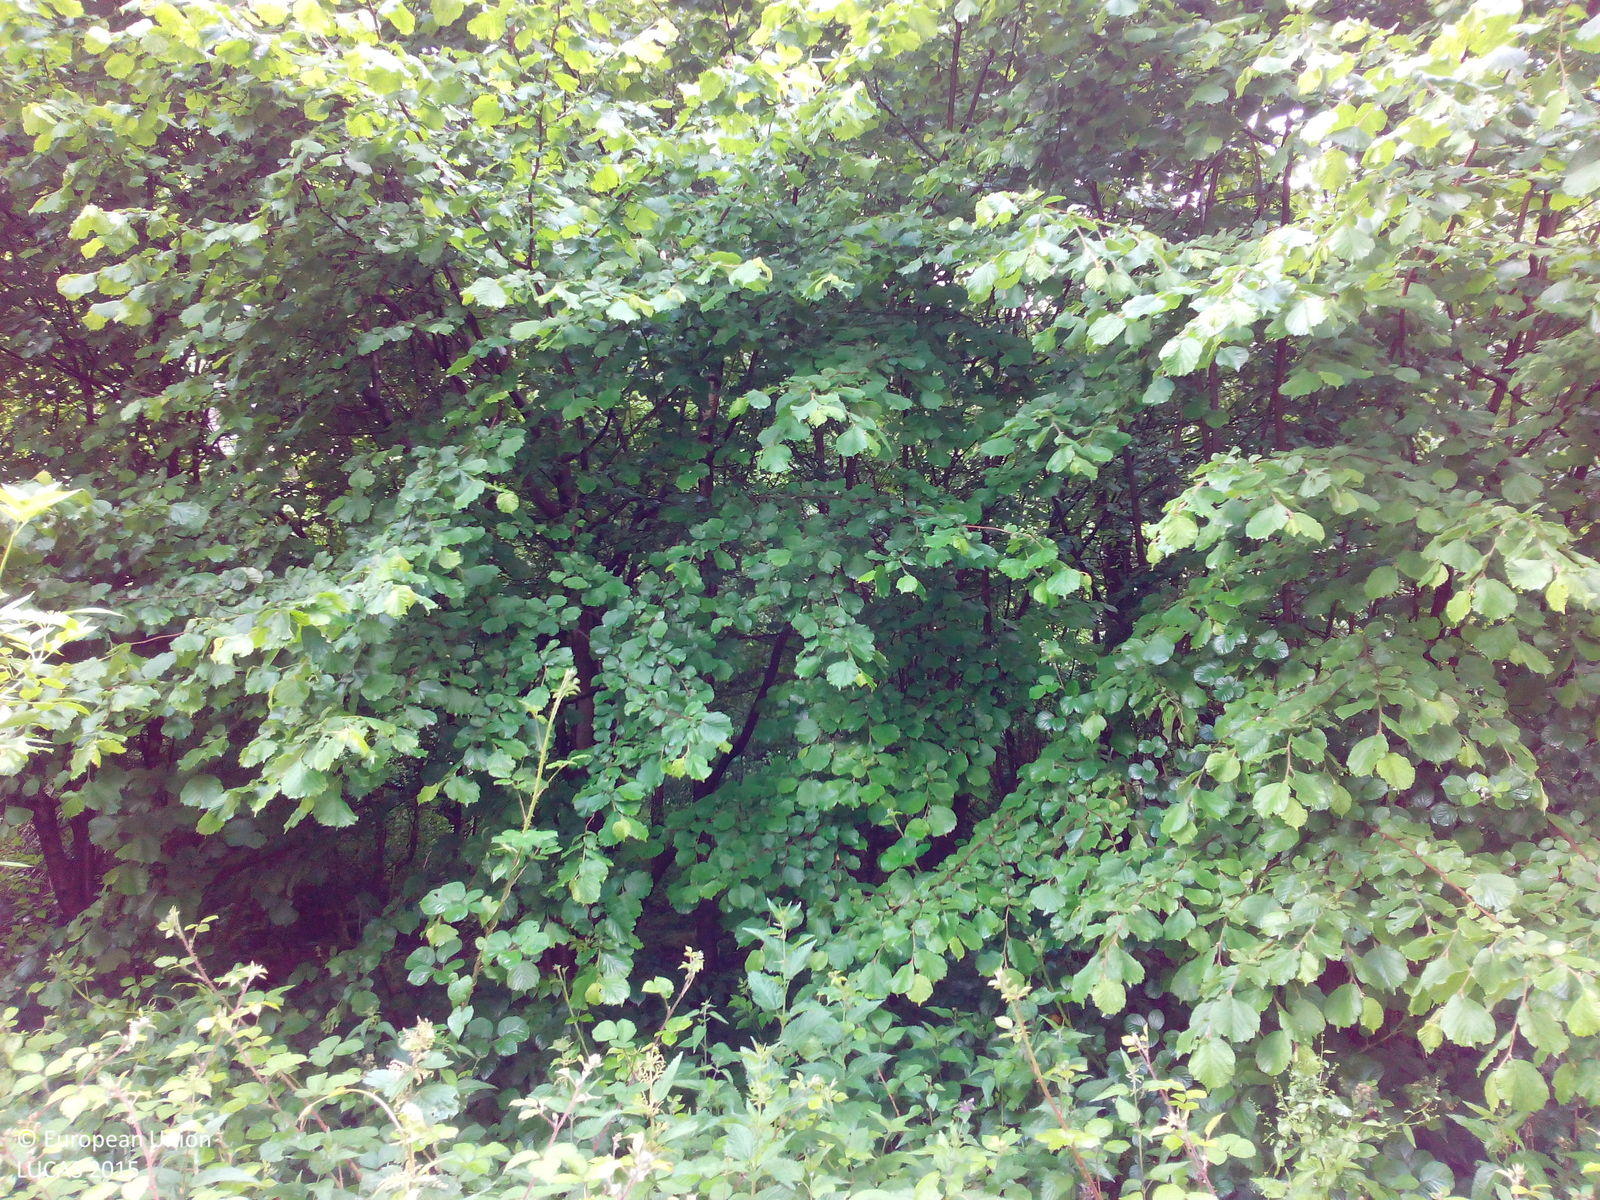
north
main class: Woodland
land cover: Spruce dominated coniferous woodland
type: hemiboreal forest and nemoral coniferous forest and mixed broadleaved-coniferous forest
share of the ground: > 75 %
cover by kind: coniferous forest trees 90 %, broadleaved forest trees 10 %
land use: Forestry
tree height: > 5 m
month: June
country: DE
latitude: 51.9100
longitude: 9.8692
